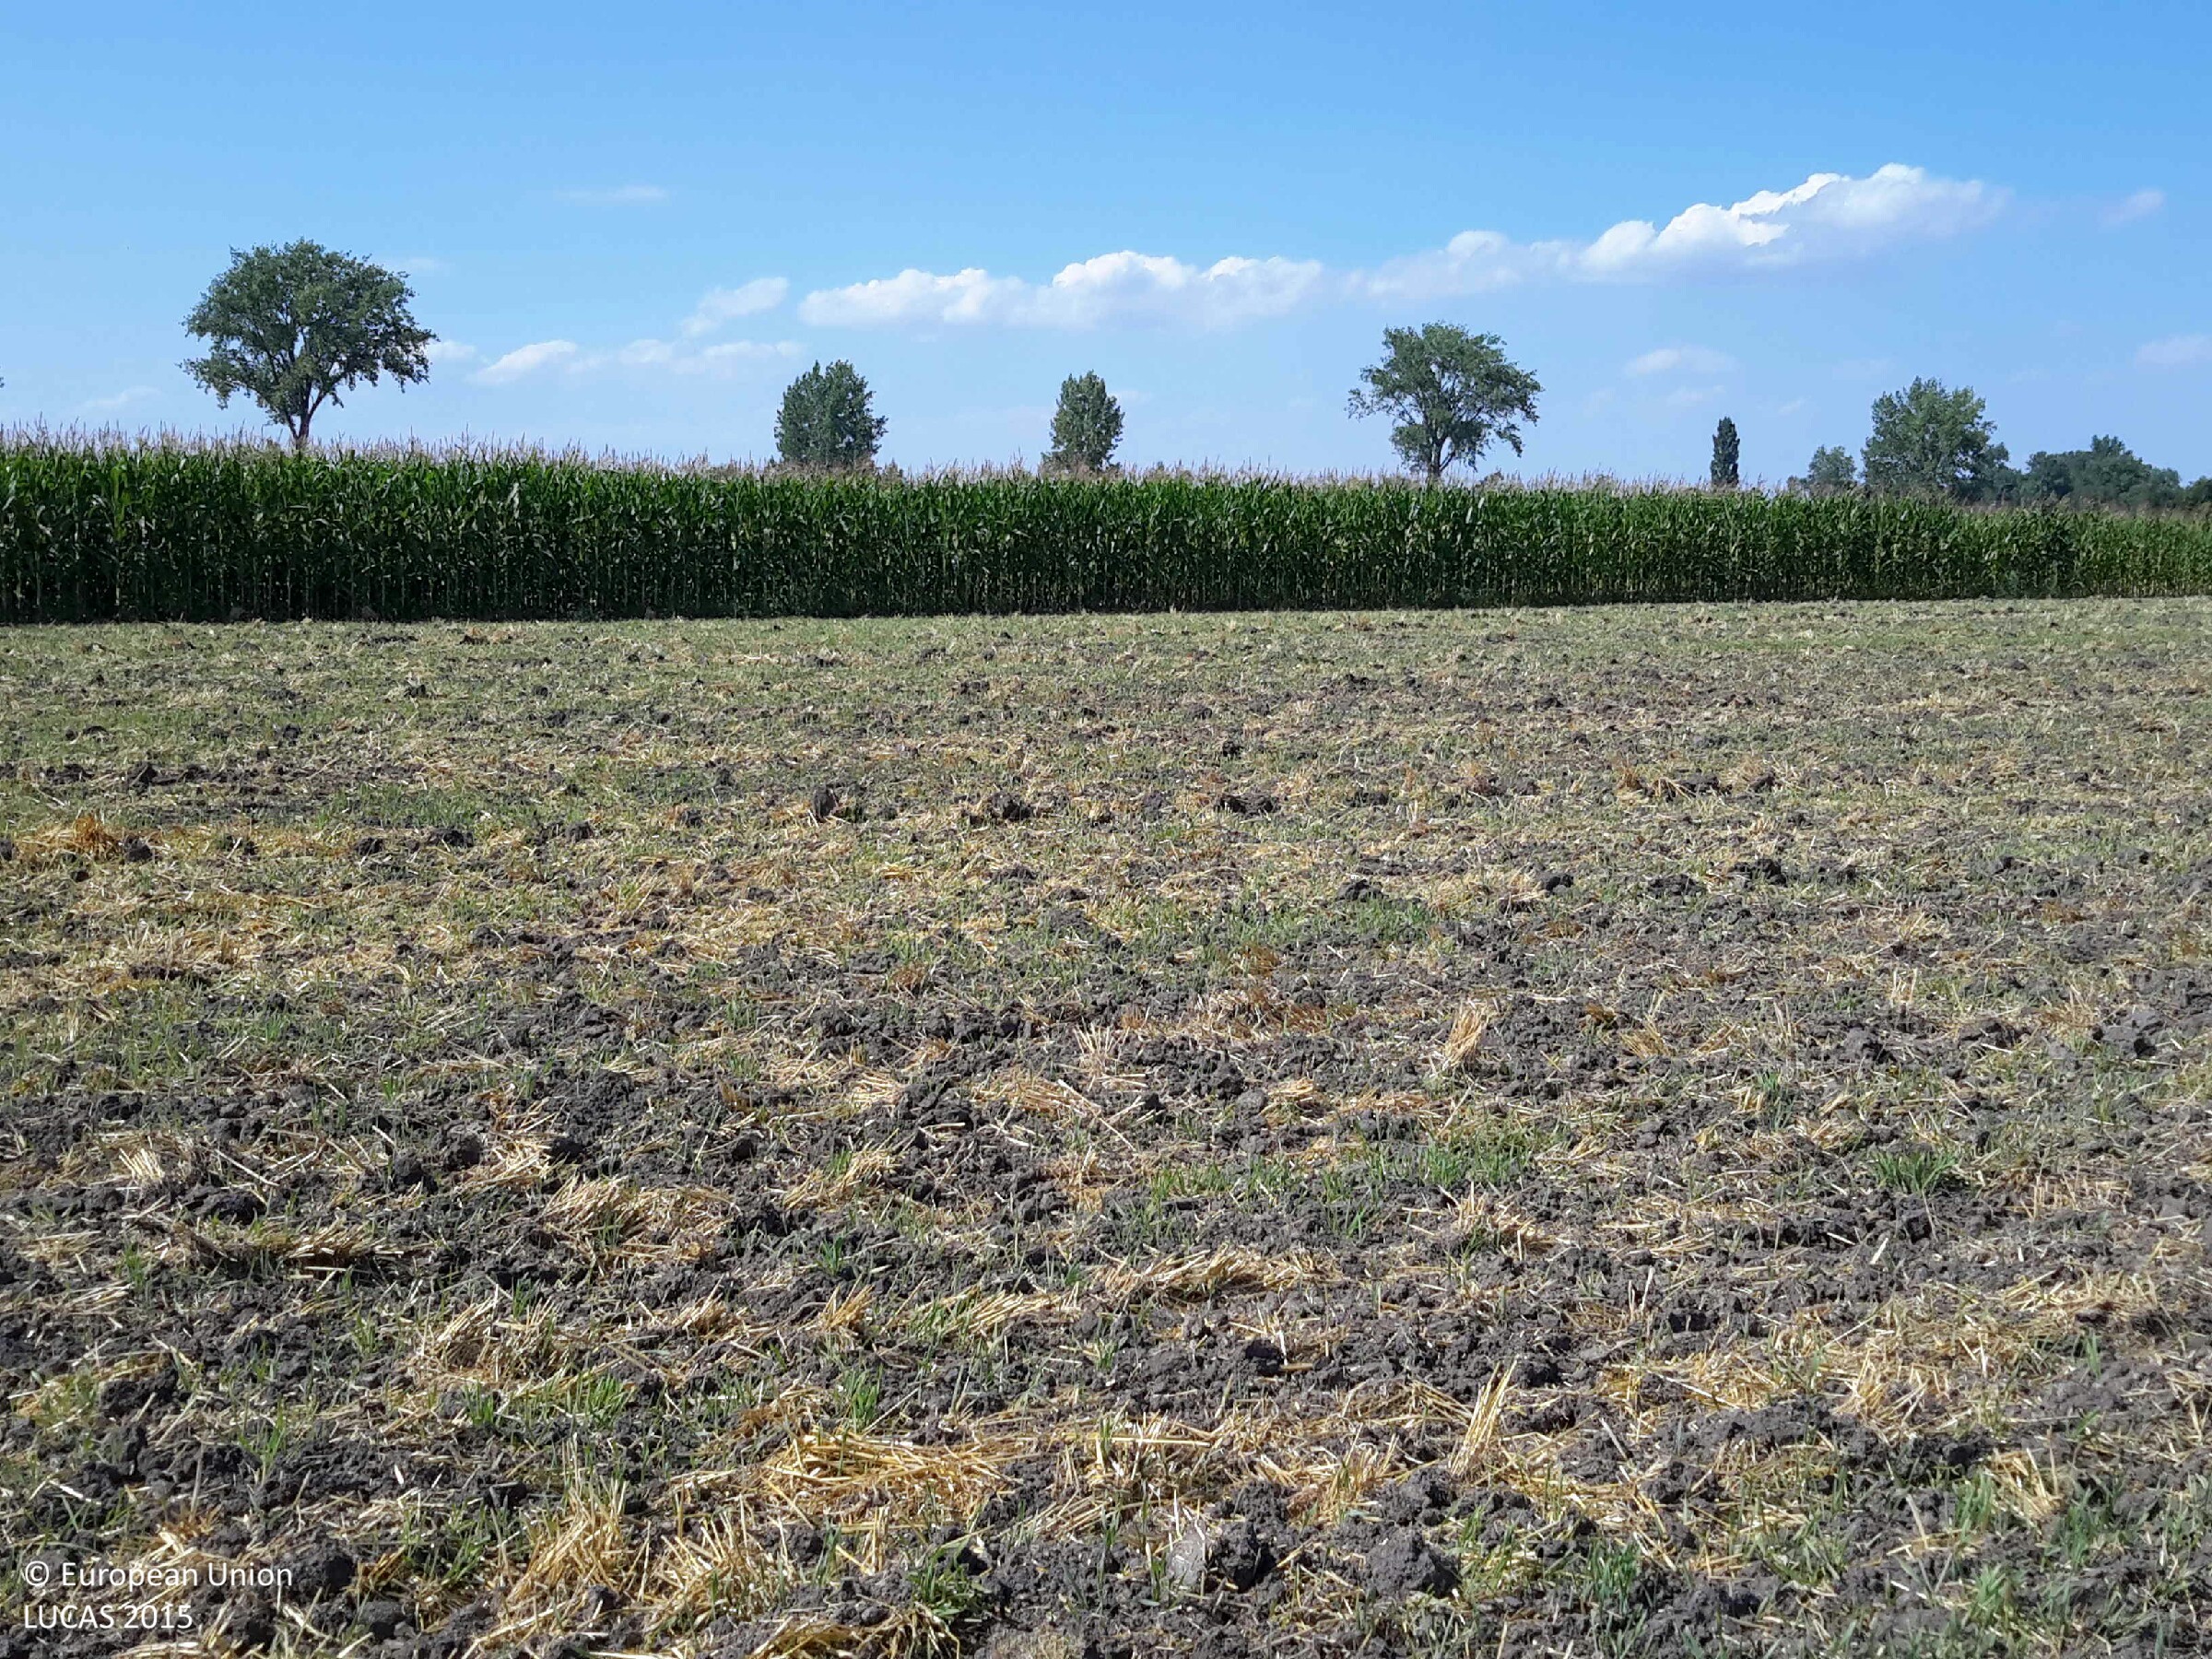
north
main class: Cropland
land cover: Common wheat
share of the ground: < 10 %
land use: Agriculture (excluding fallow land and kitchen gardens)
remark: Harvested field
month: July
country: HU
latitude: 47.5626
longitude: 17.8651
